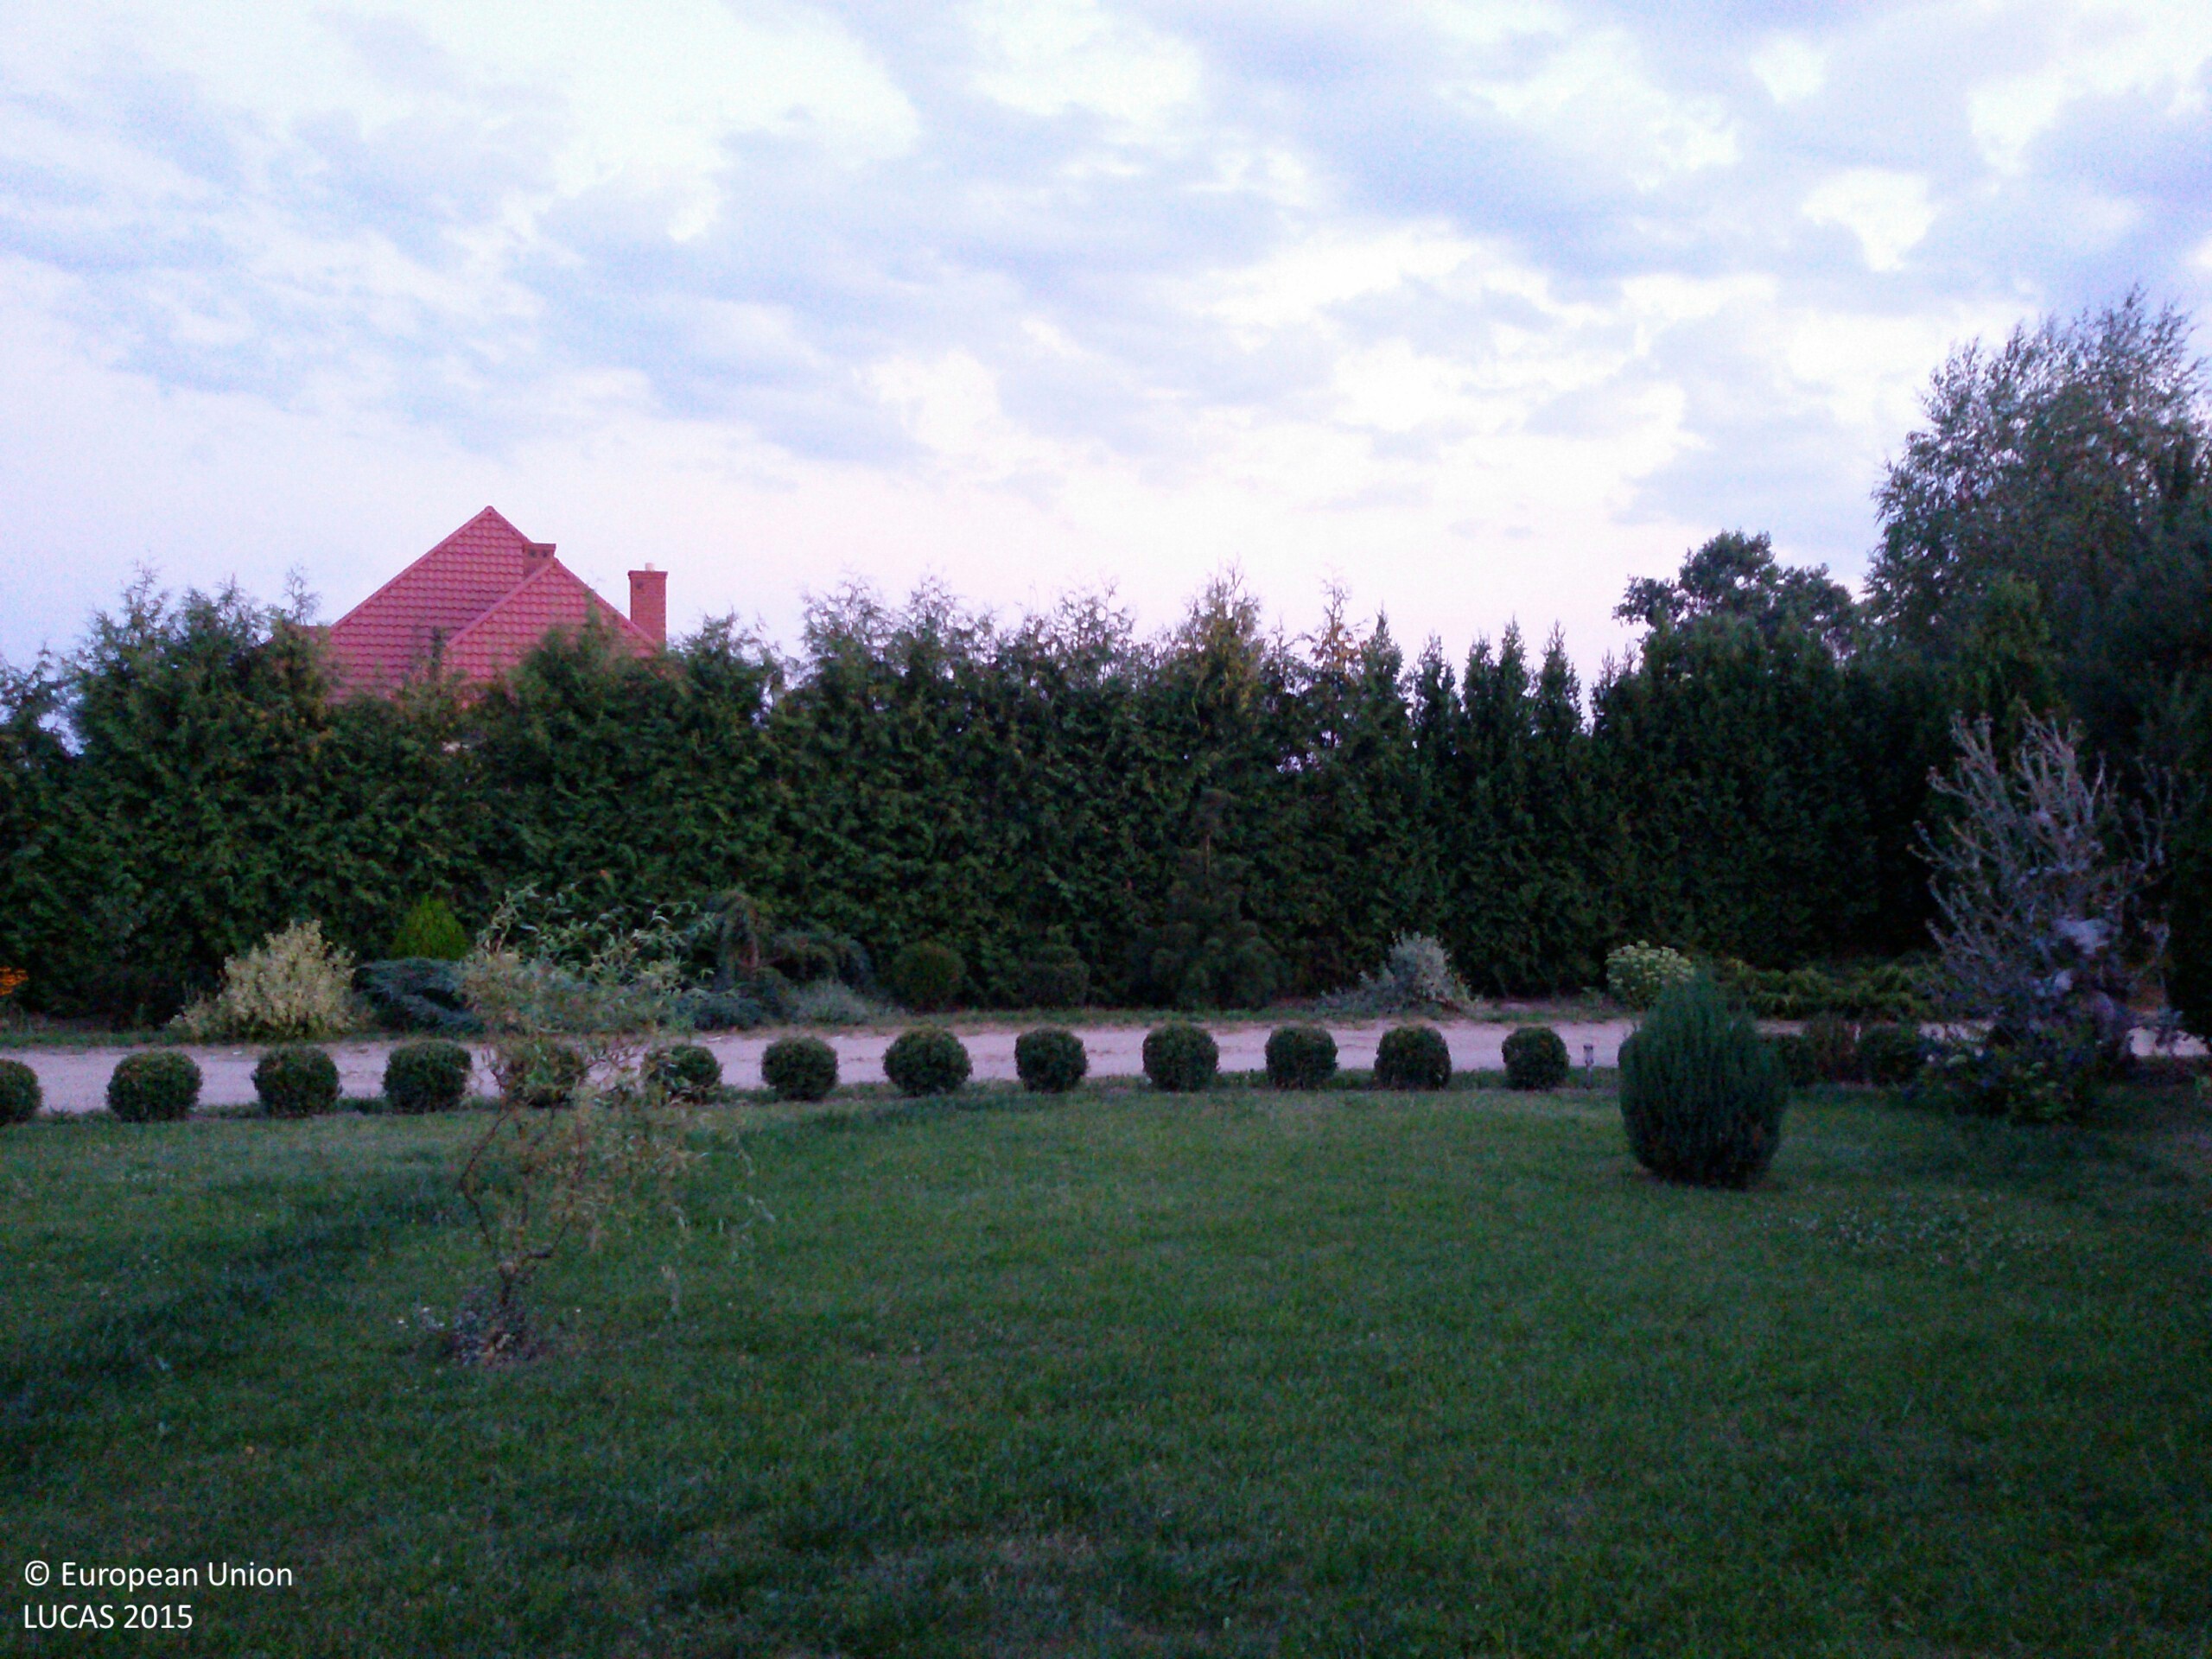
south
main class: Woodland
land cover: Broadleaved woodland
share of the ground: 10 - 25 %
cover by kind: shrubs 65 %, herbaceous plants 25 %, broadleaved forest trees 10 %
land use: Residential
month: August
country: PL
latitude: 51.4455
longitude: 22.9518
